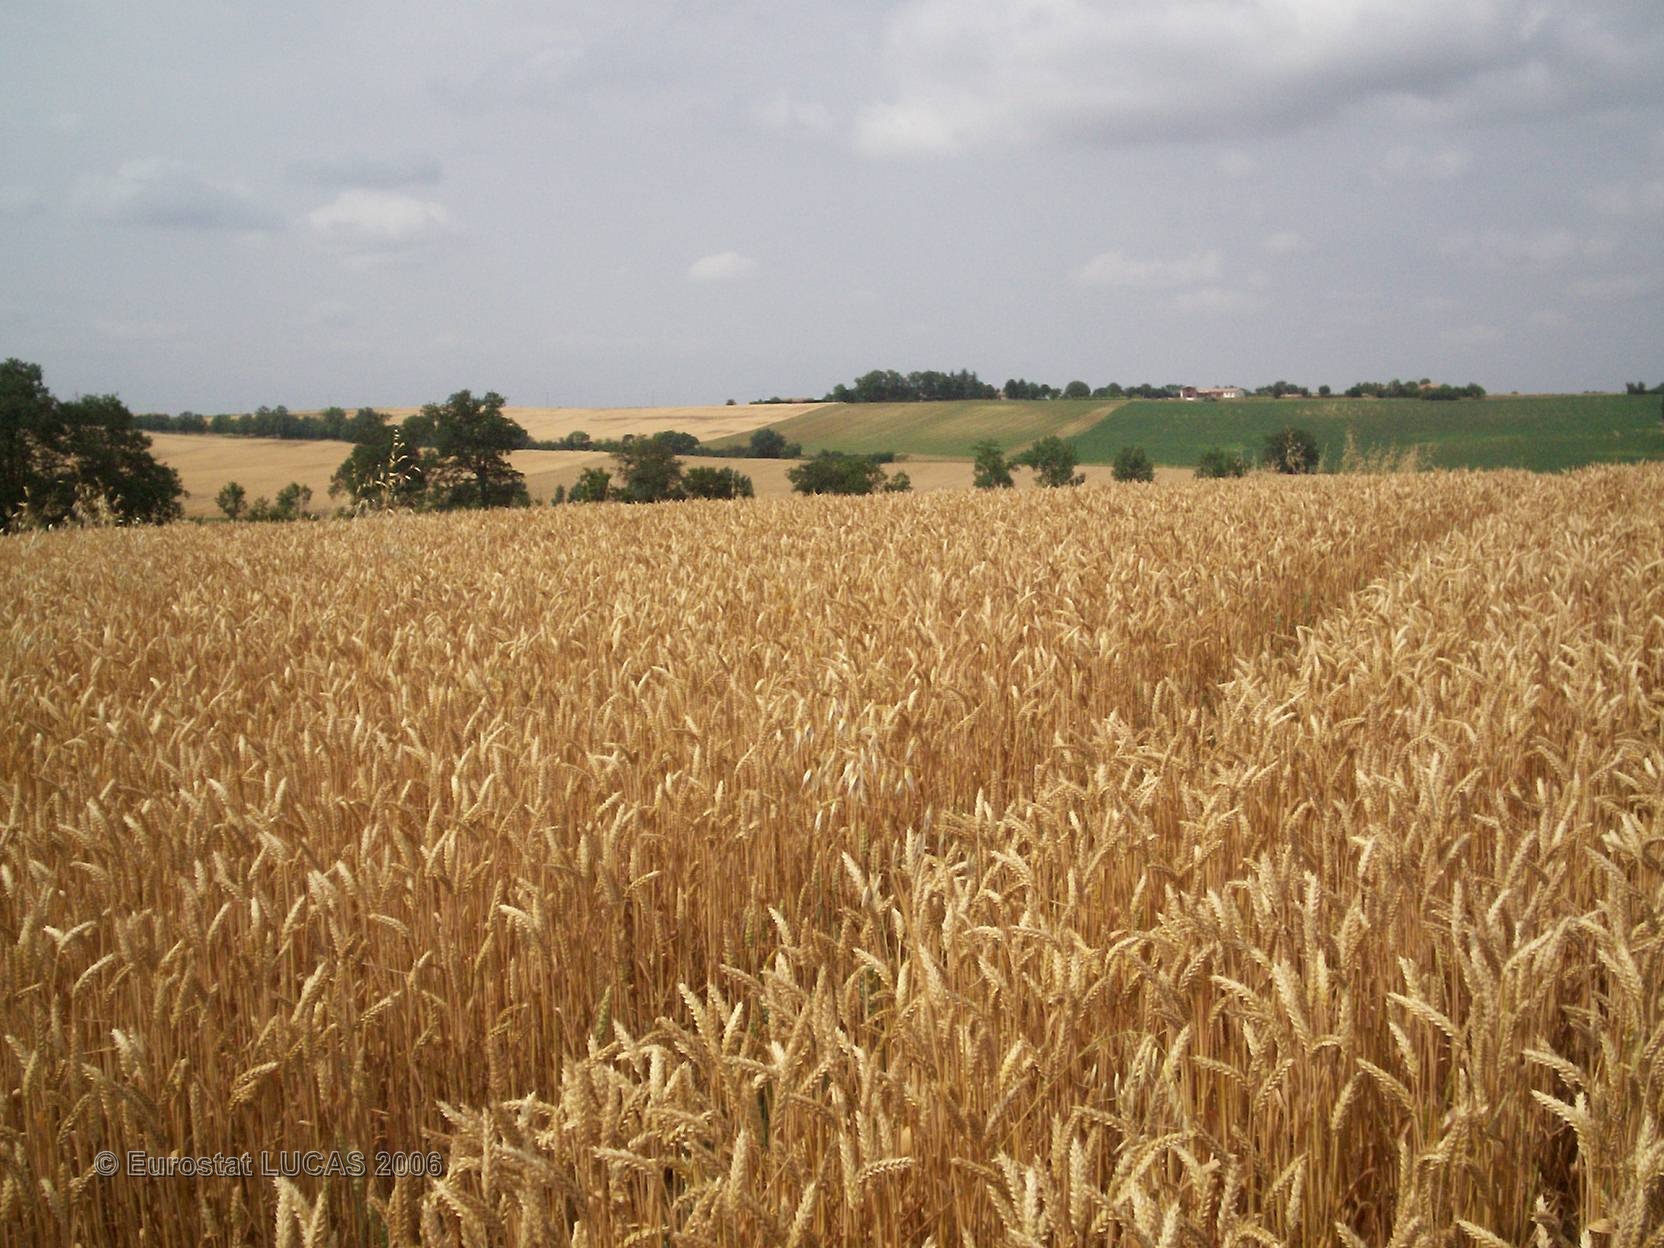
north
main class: Cropland
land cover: Common wheat
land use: Agriculture (excluding fallow land and kitchen gardens)
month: June
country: FR
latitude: 43.6893
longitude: 1.0303
